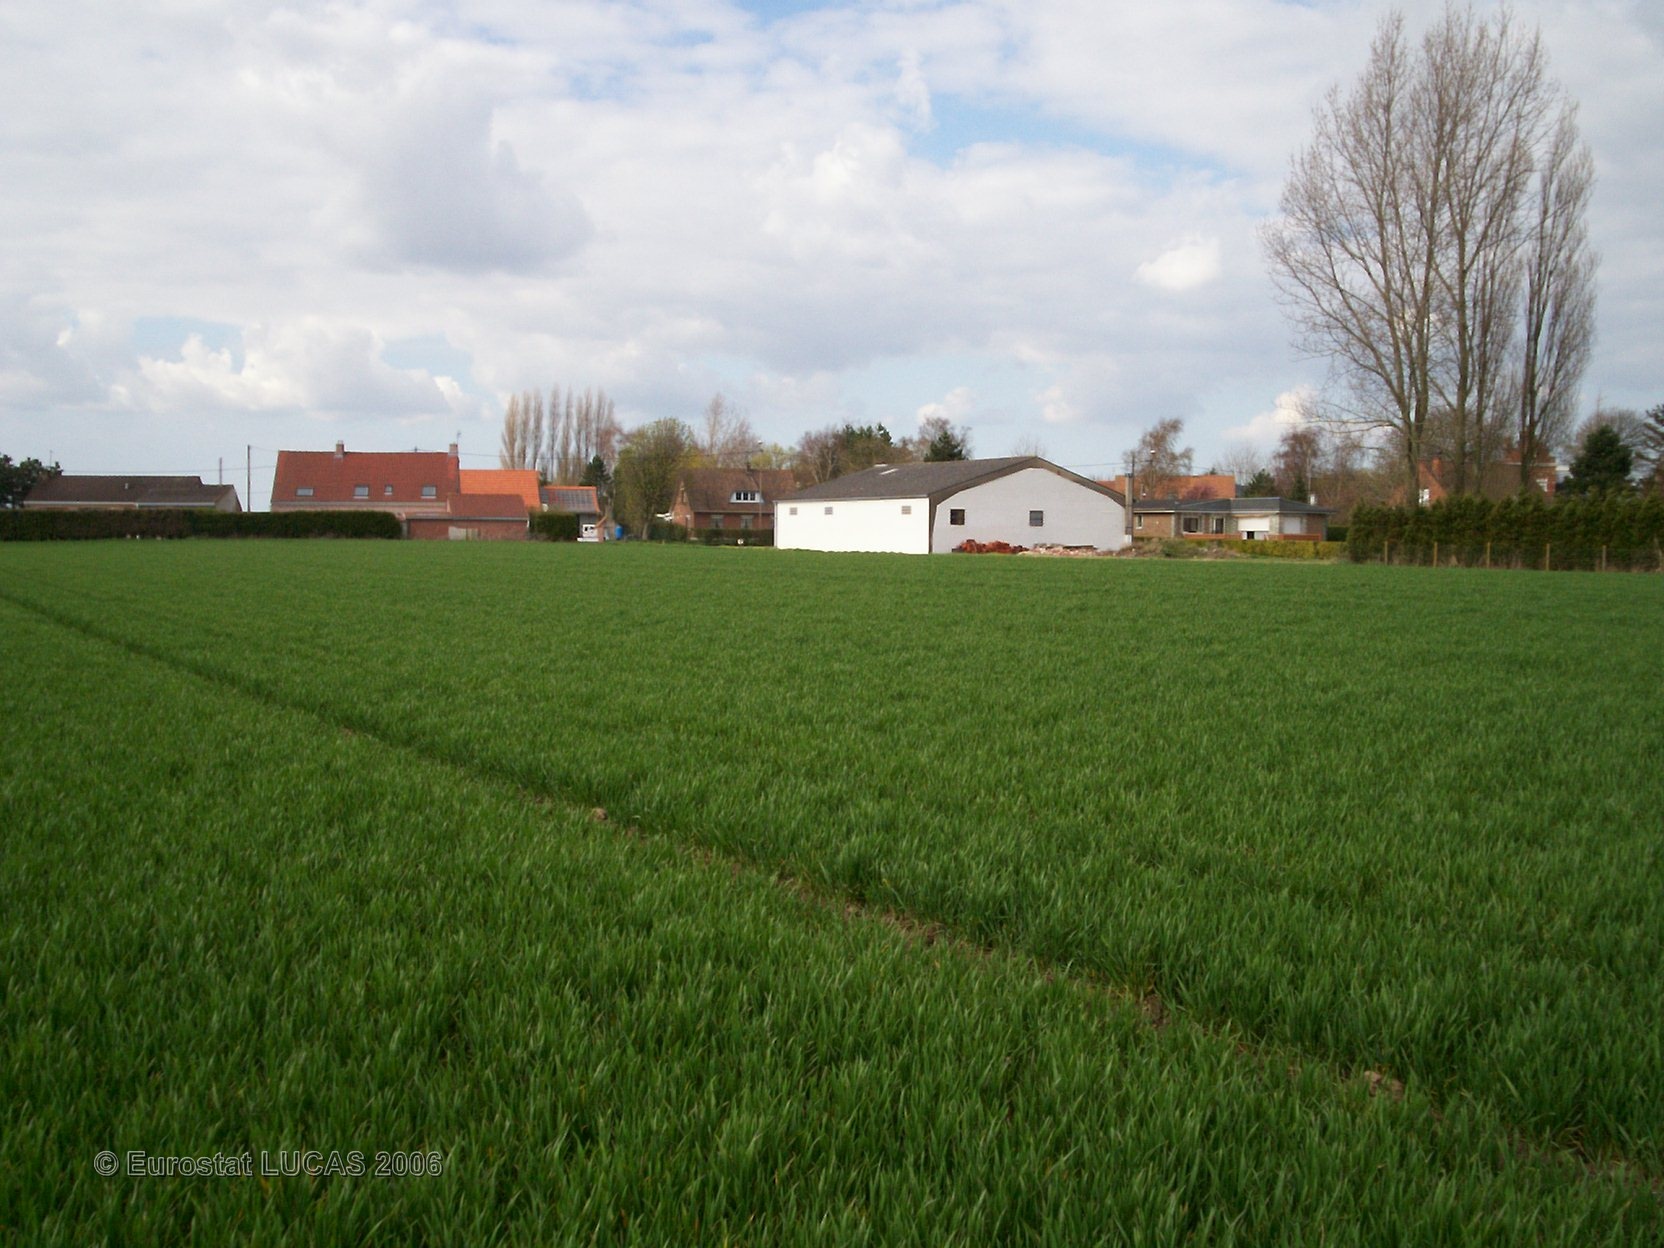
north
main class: Cropland
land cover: Common wheat
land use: Agriculture (excluding fallow land and kitchen gardens)
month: April
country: FR
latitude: 50.8883
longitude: 2.4098
